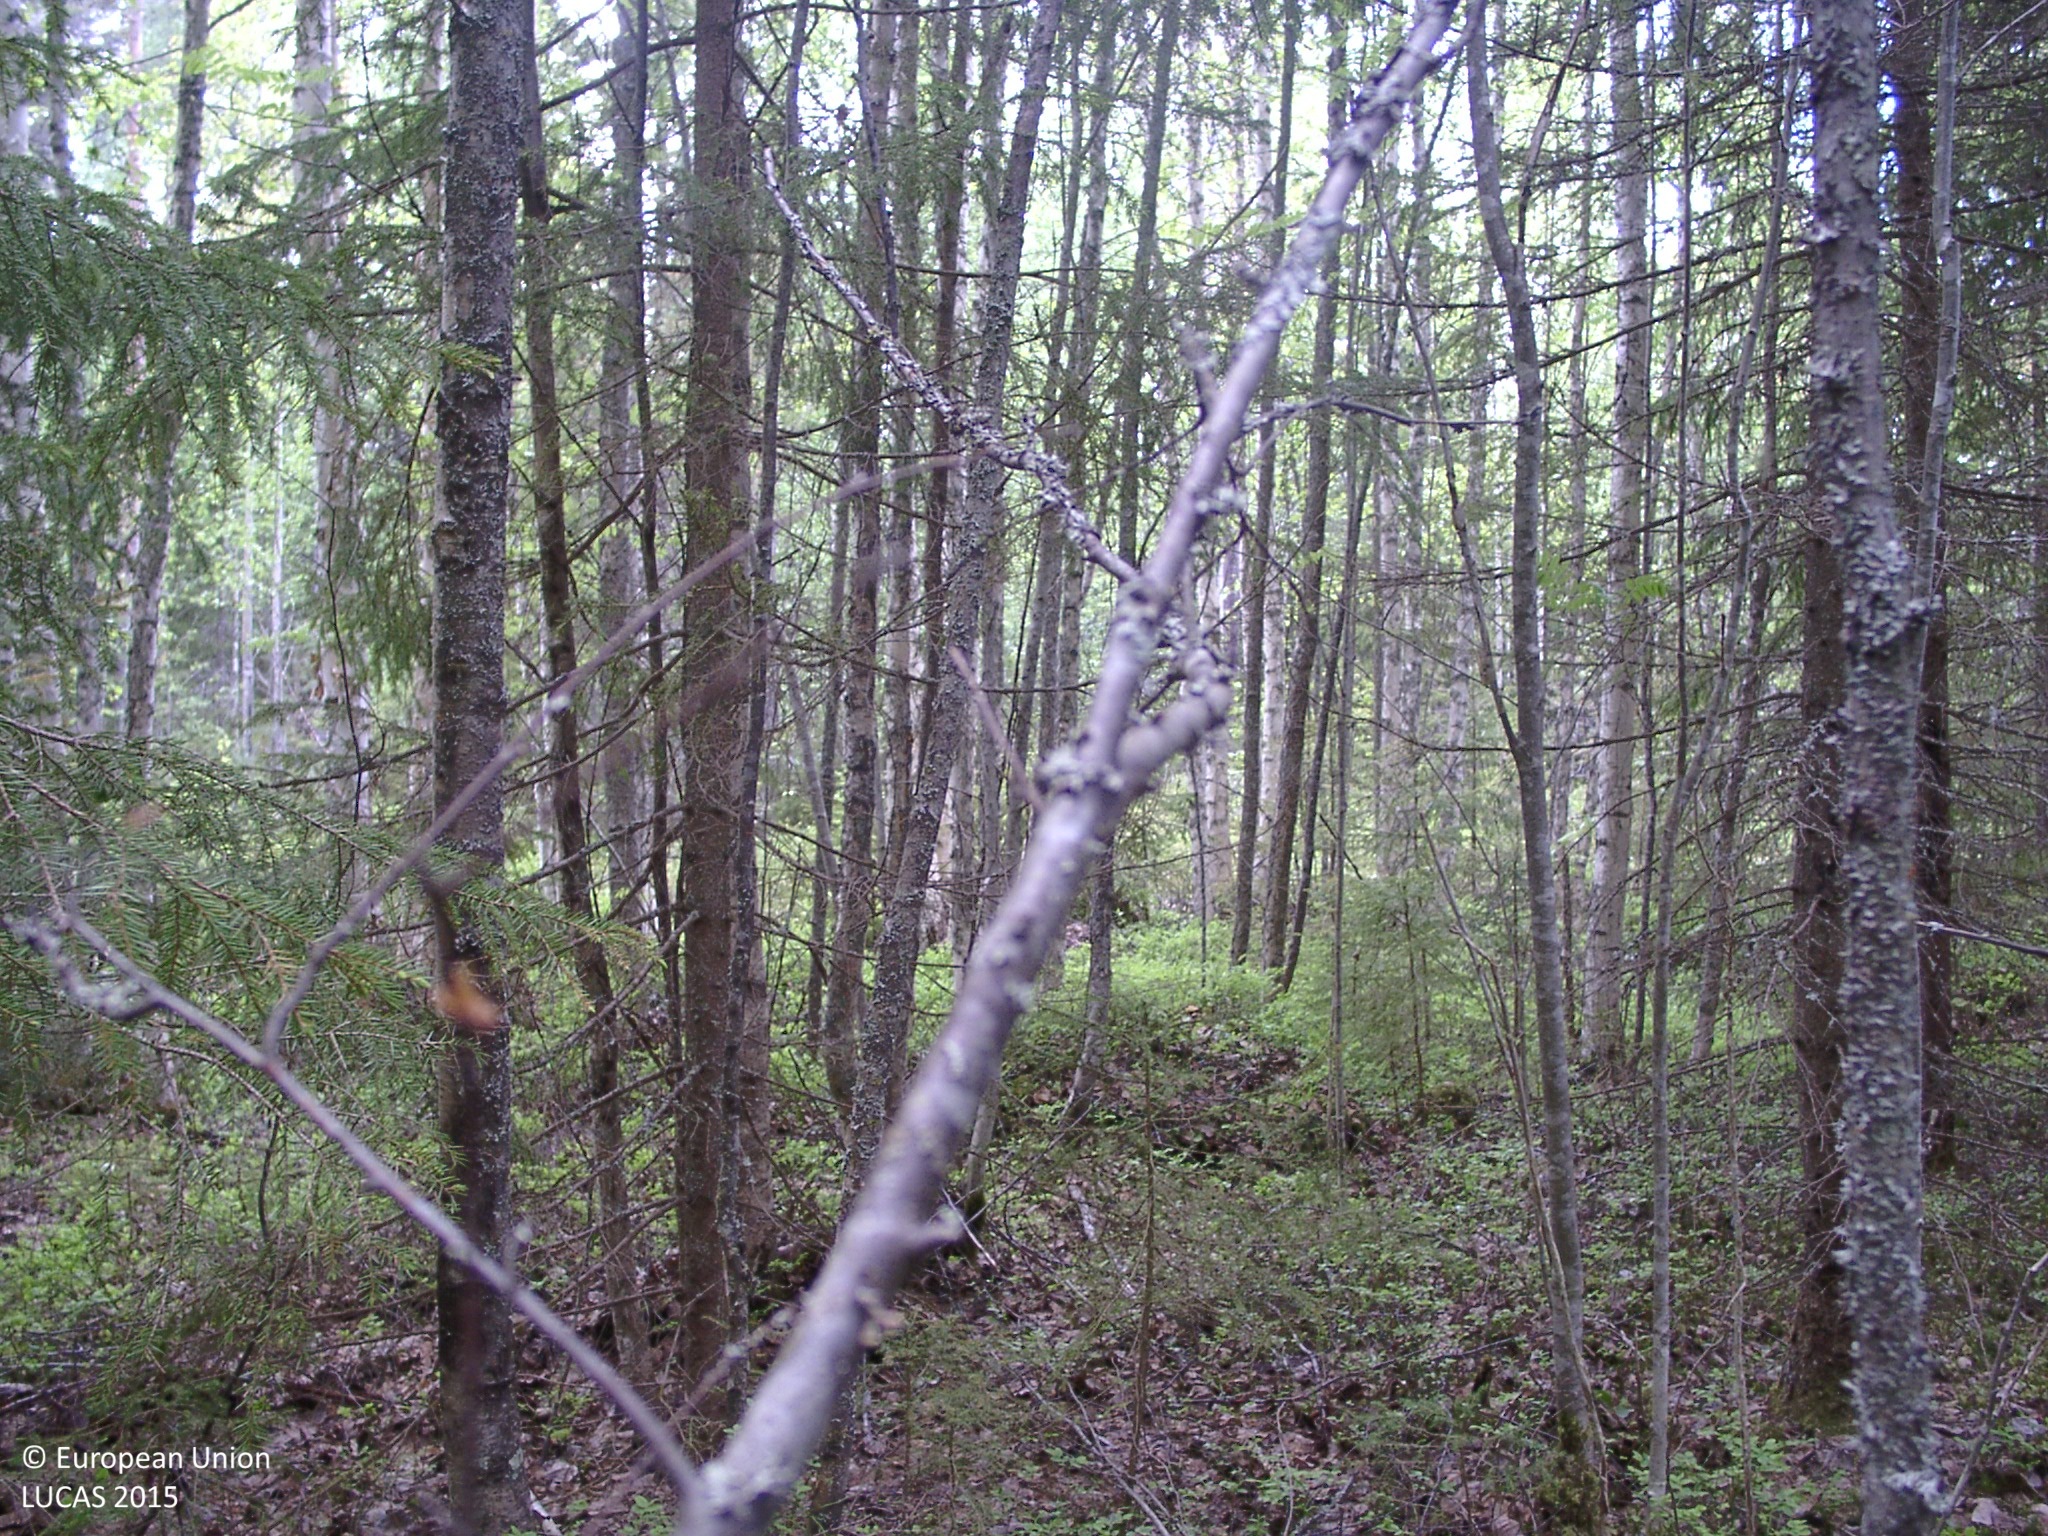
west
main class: Woodland
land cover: Spruce dominated mixed woodland
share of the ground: > 75 %
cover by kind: broadleaved forest trees 45 %, coniferous forest trees 35 %, shrubs 15 %, lichens and mosses 5 %
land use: Semi-natural and natural areas not in use
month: June
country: FI
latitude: 62.1327
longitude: 25.5150
